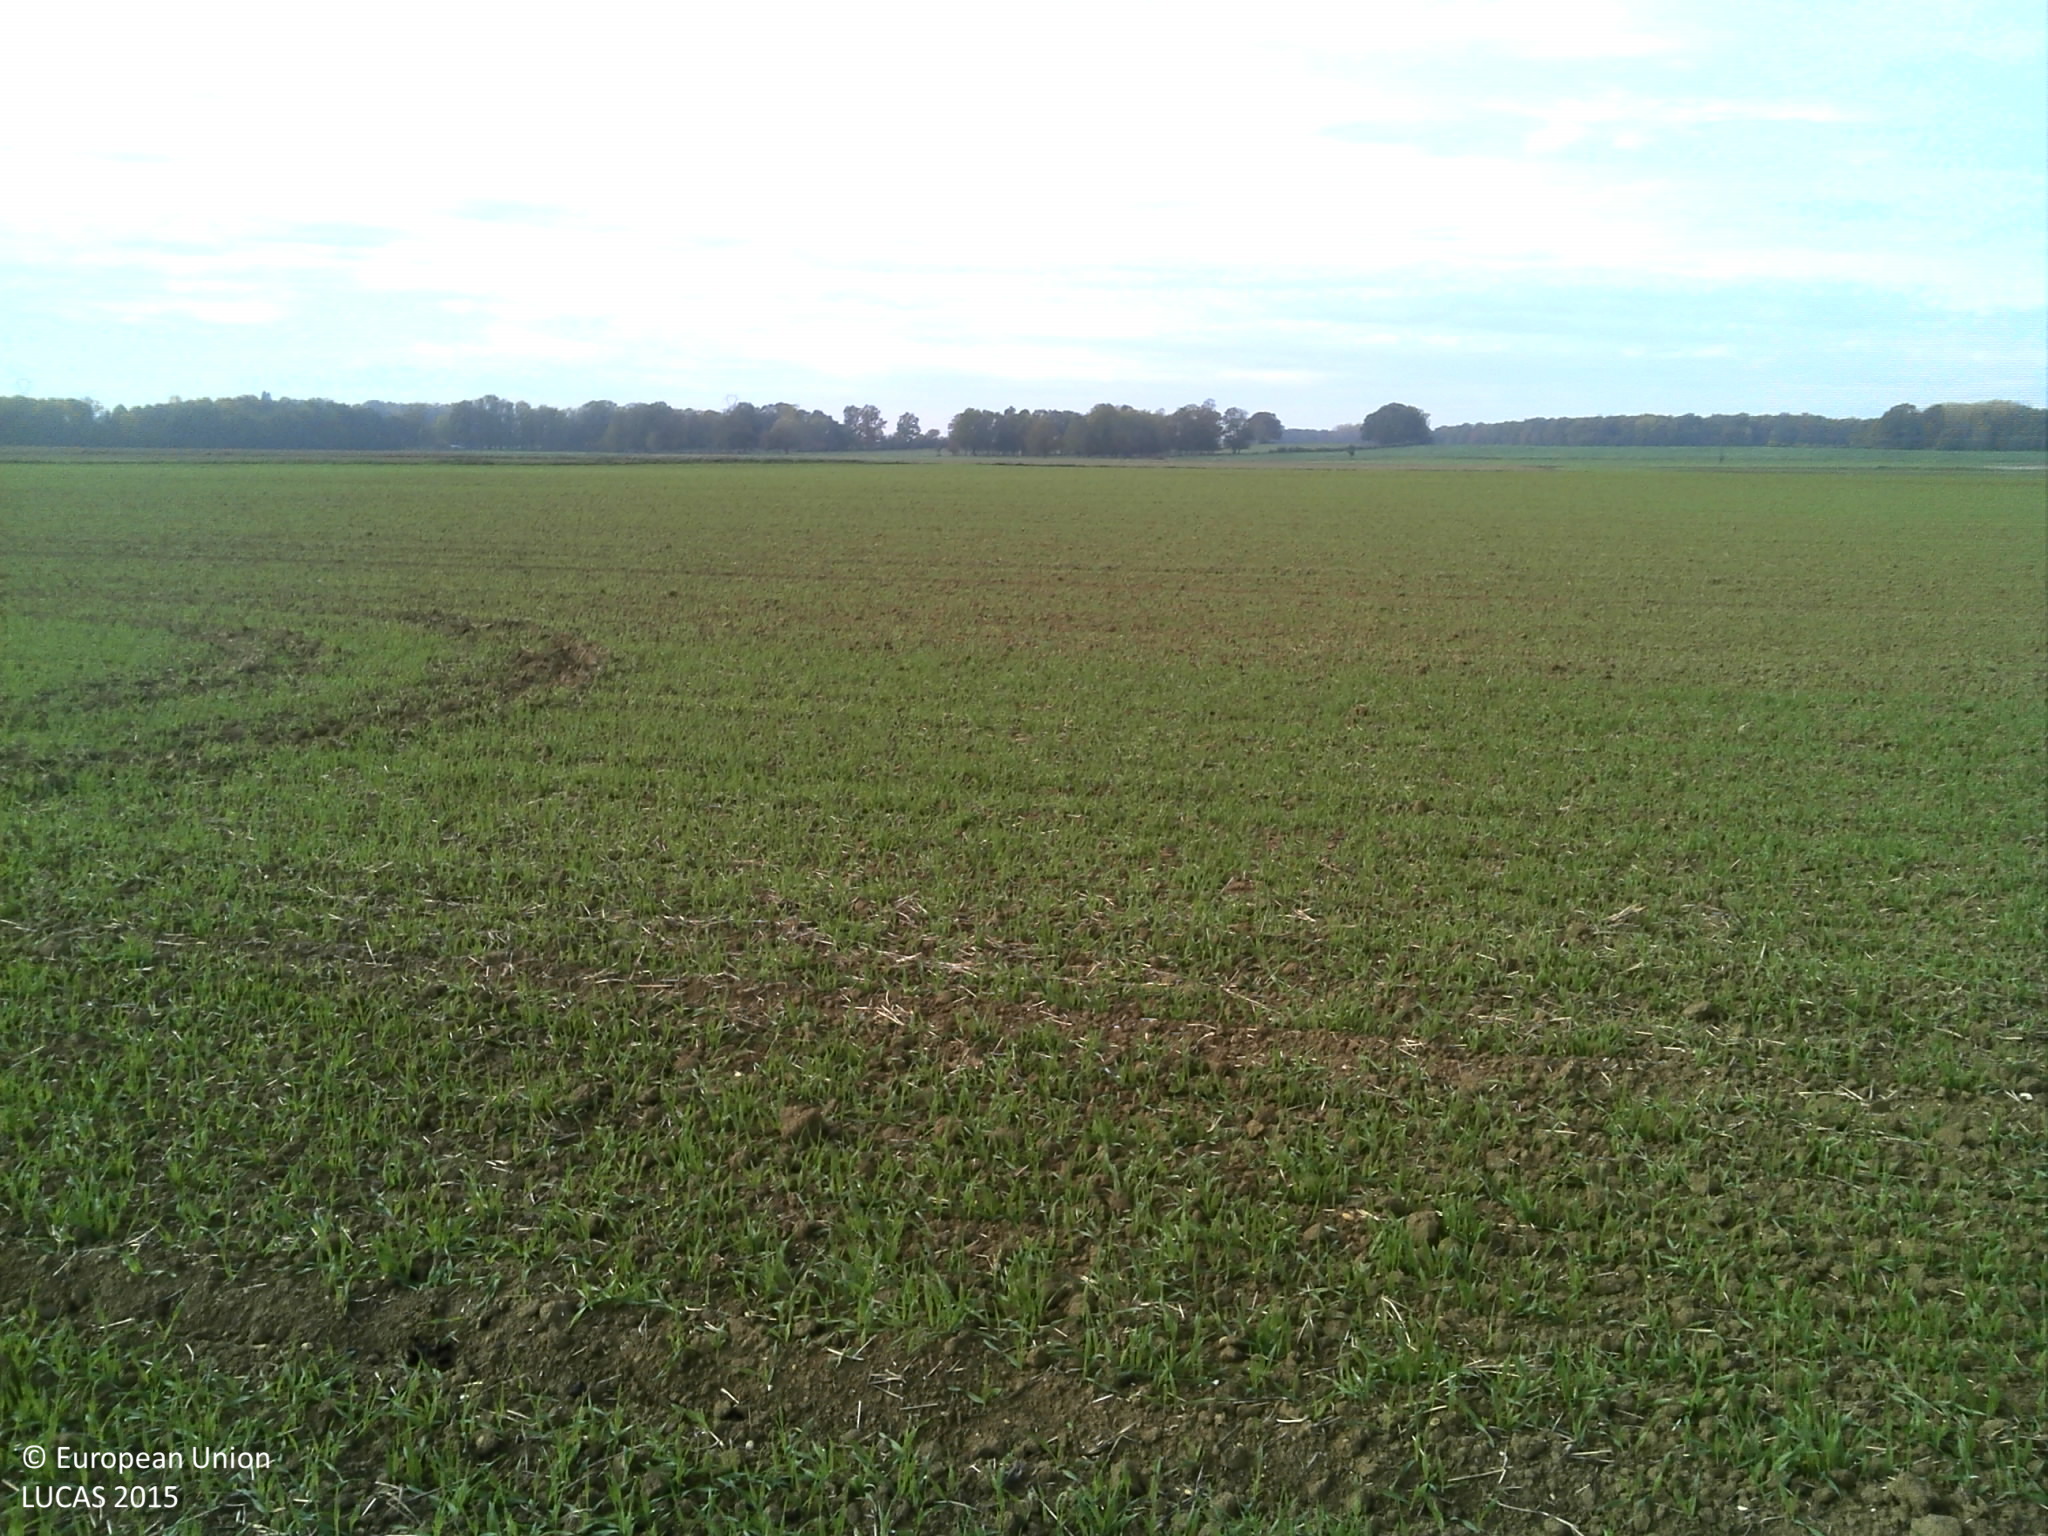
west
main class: Cropland
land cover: Common wheat
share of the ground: > 75 %
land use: Agriculture (excluding fallow land and kitchen gardens)
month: October
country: FR
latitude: 47.1484
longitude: 5.2668
